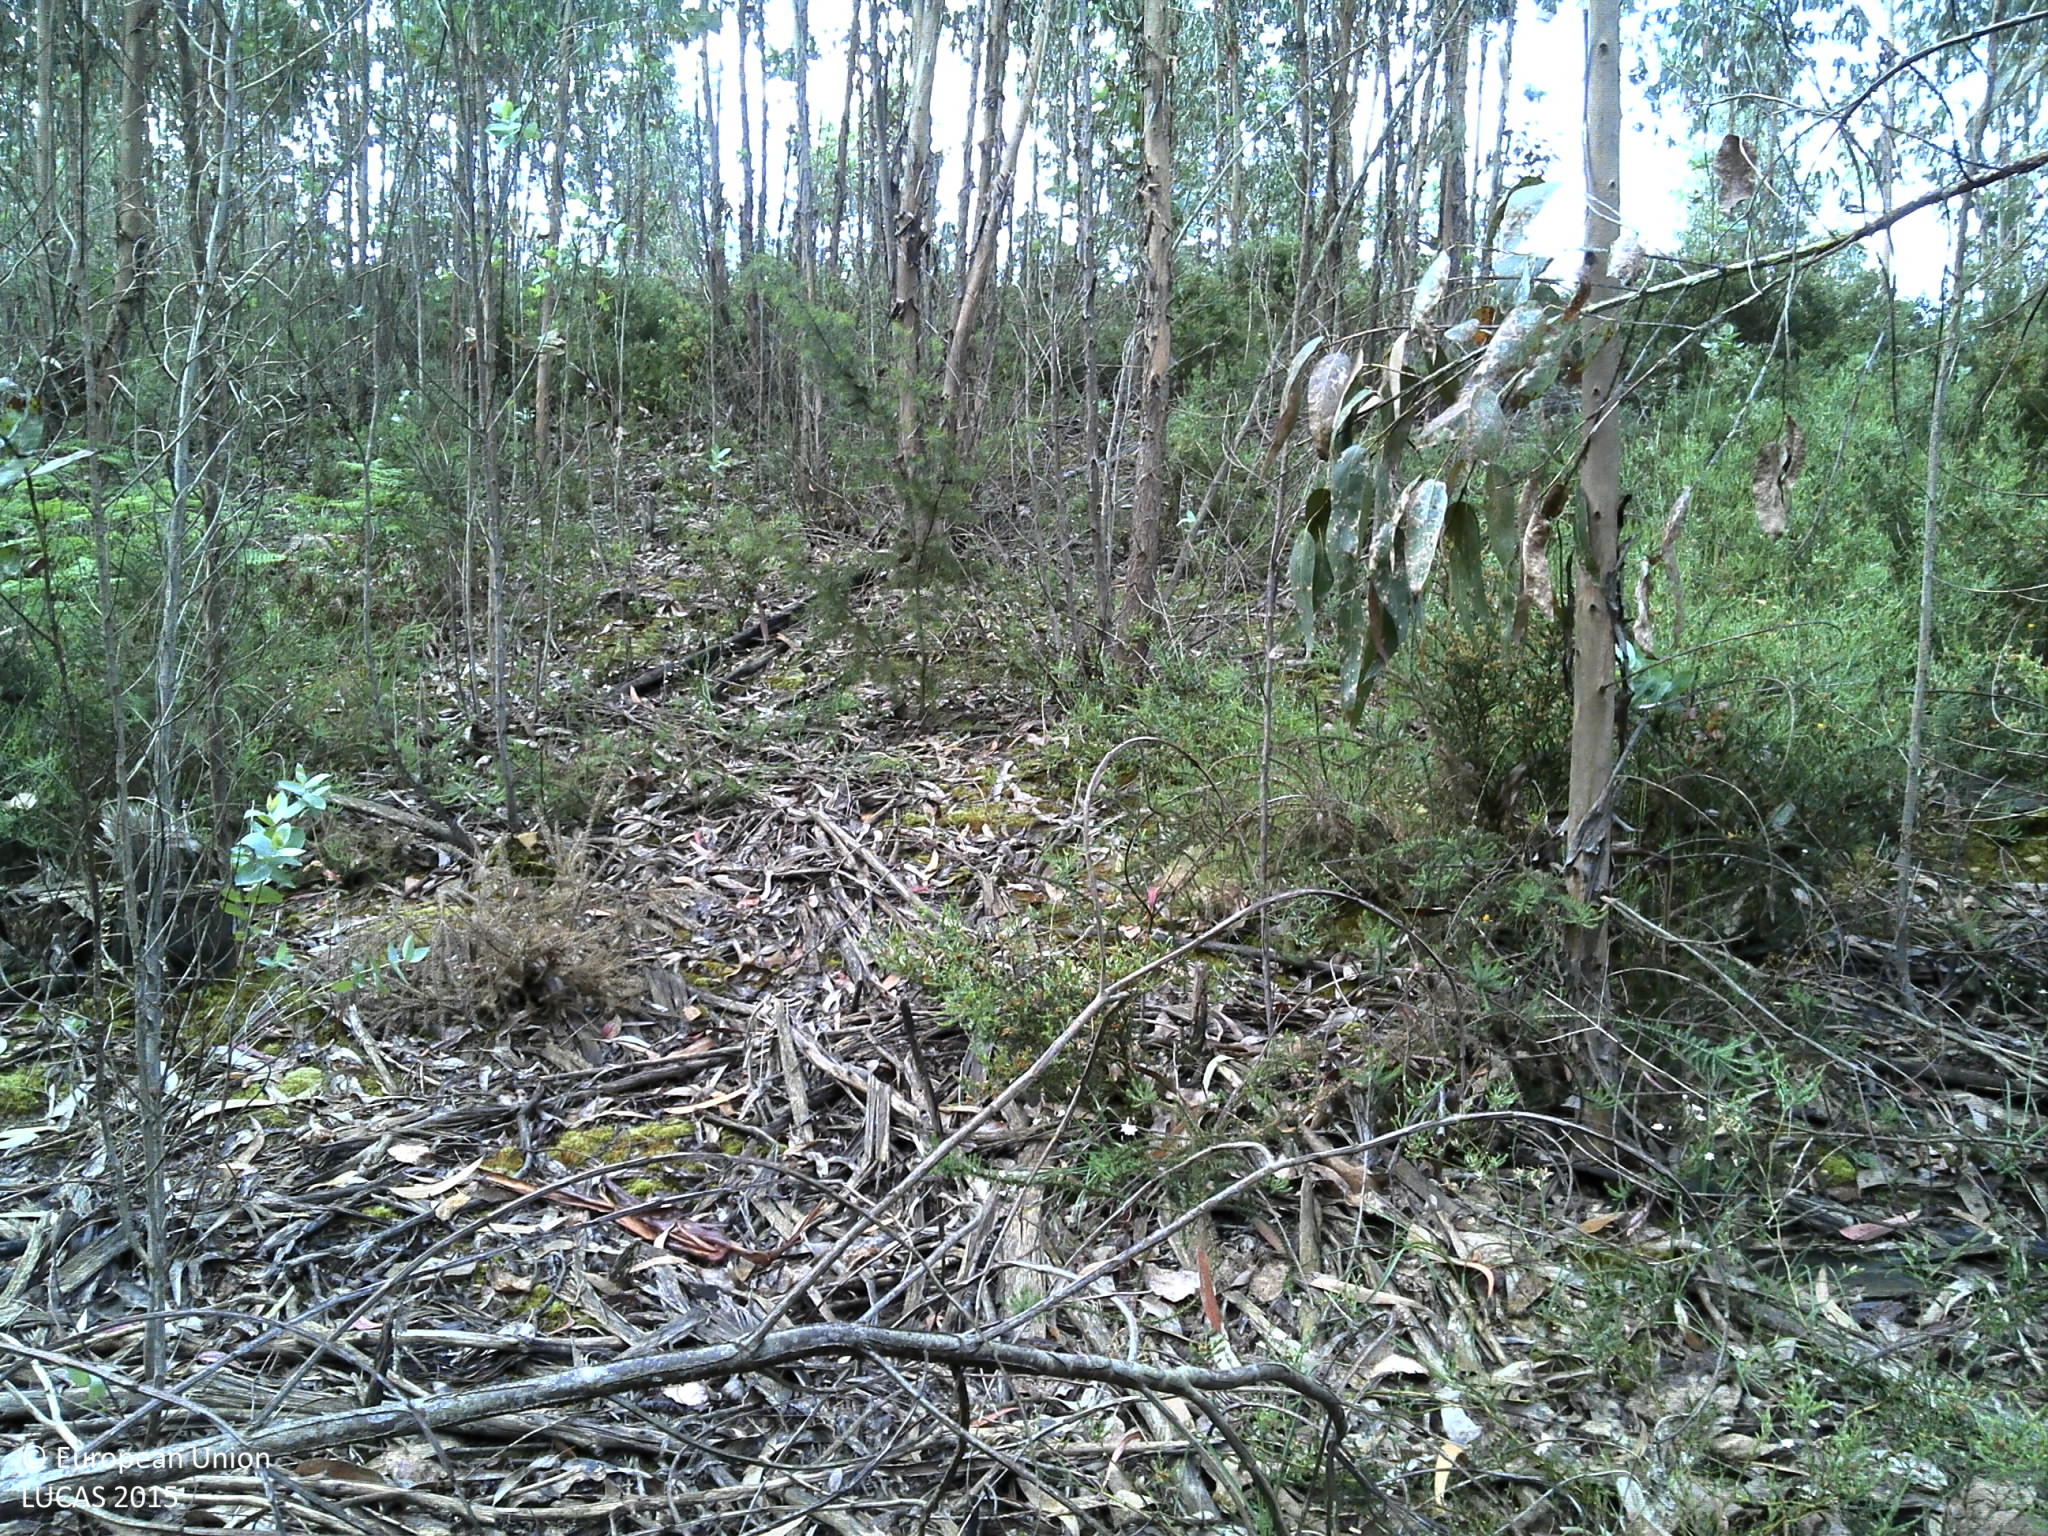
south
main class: Woodland
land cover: Broadleaved woodland
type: exotic forest
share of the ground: 50 - 75 %
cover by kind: broadleaved forest trees 60 %, shrubs 30 %, herbaceous plants 5 %, unconsolidated bare surface 5 %
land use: Forestry
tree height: < 5 m
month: May
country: PT
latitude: 41.2128
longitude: -8.4816
